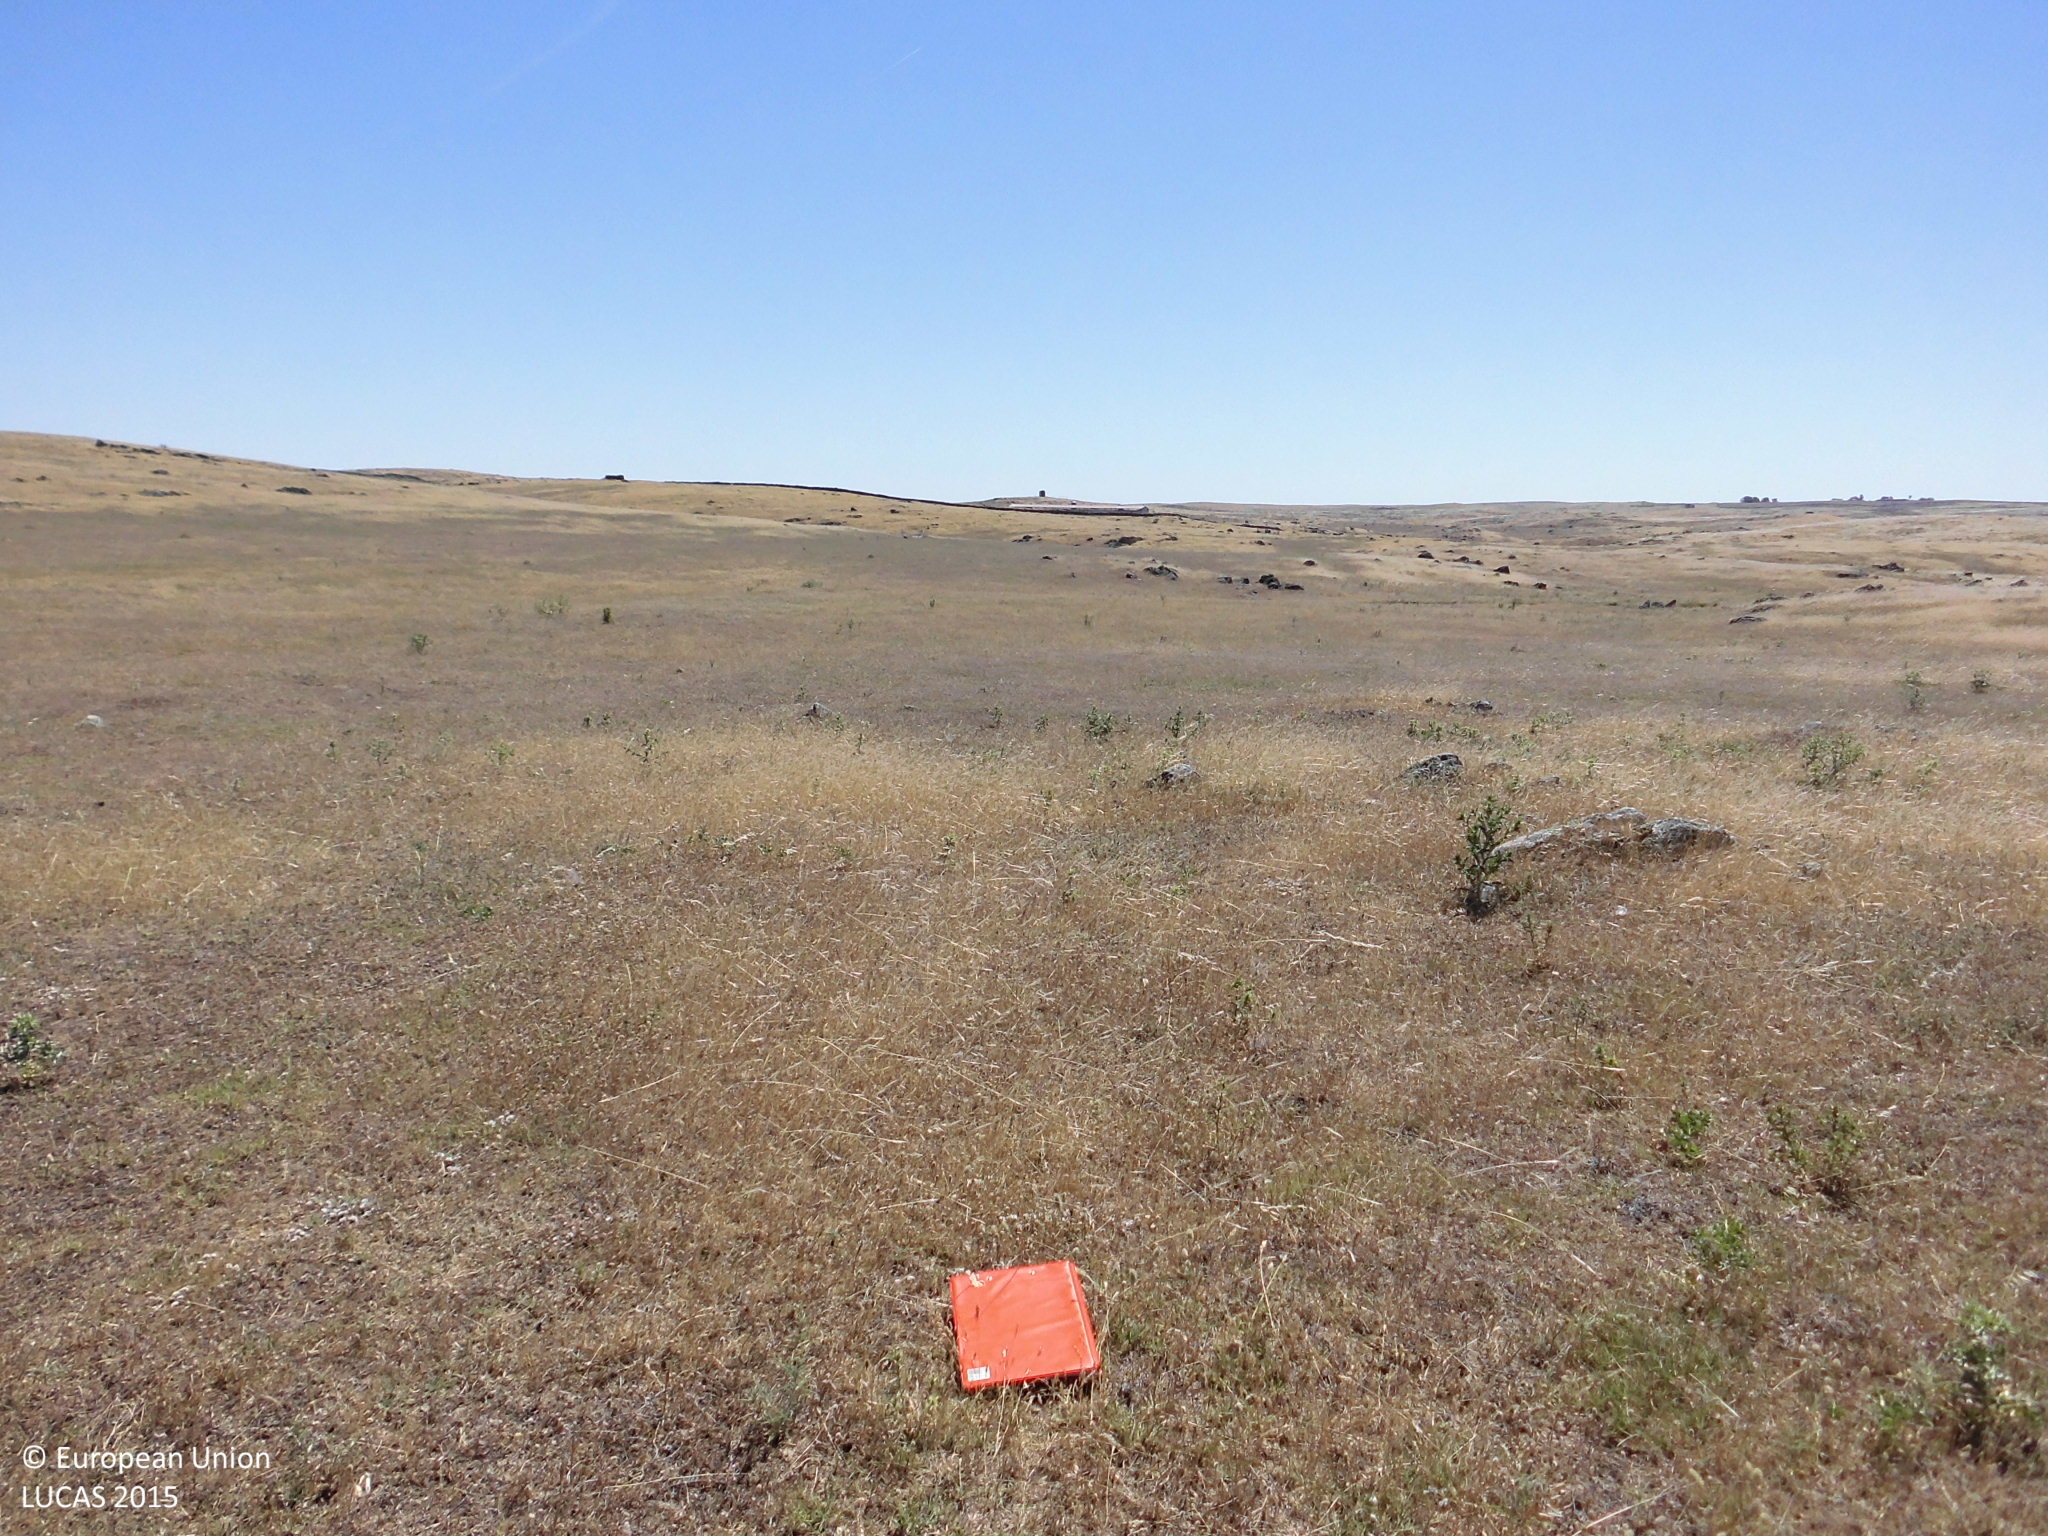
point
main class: Grassland
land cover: Grassland without tree/shrub cover
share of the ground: > 75 %
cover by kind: herbaceous plants 100 %
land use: Agriculture (excluding fallow land and kitchen gardens)
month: May
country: ES
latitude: 39.5716
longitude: -6.8543
